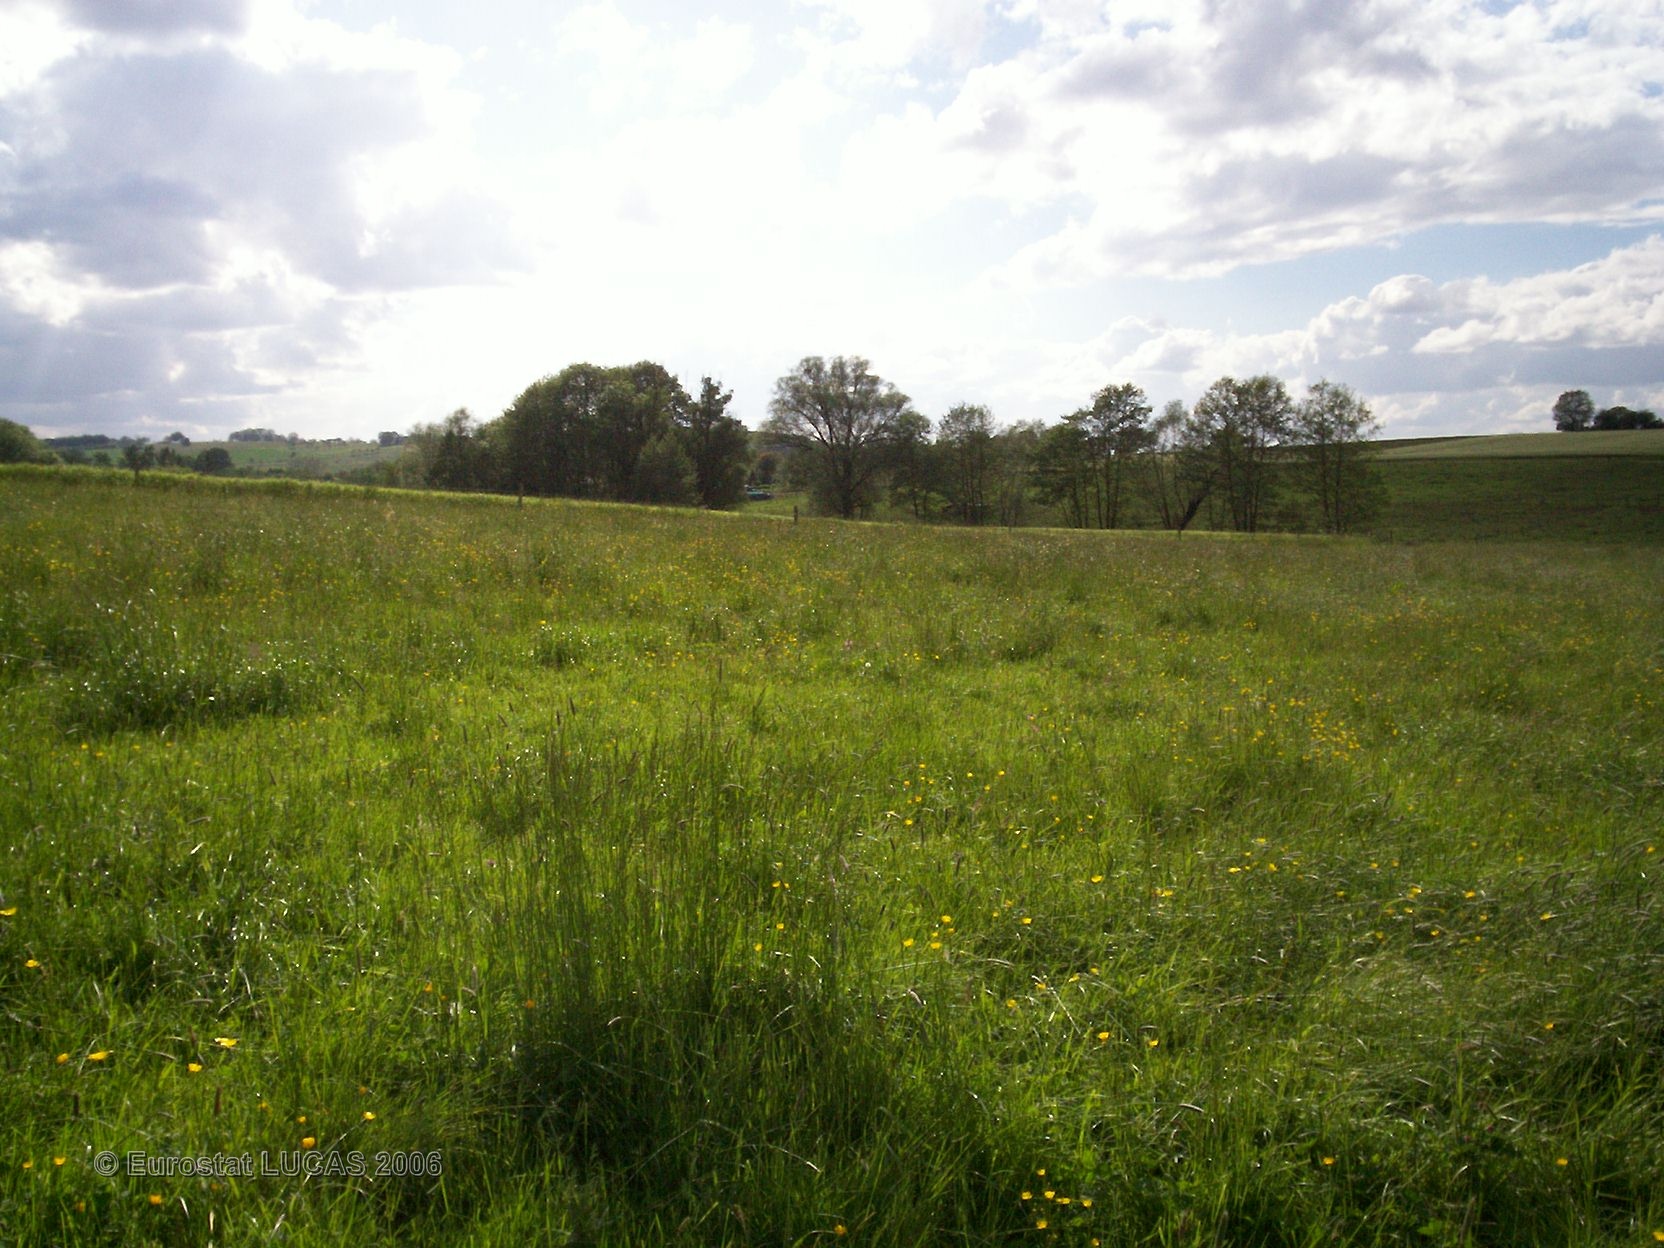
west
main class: Grassland
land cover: Grassland without tree/shrub cover
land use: Agriculture (excluding fallow land and kitchen gardens)
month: May
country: FR
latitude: 48.5183
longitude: 6.7649
